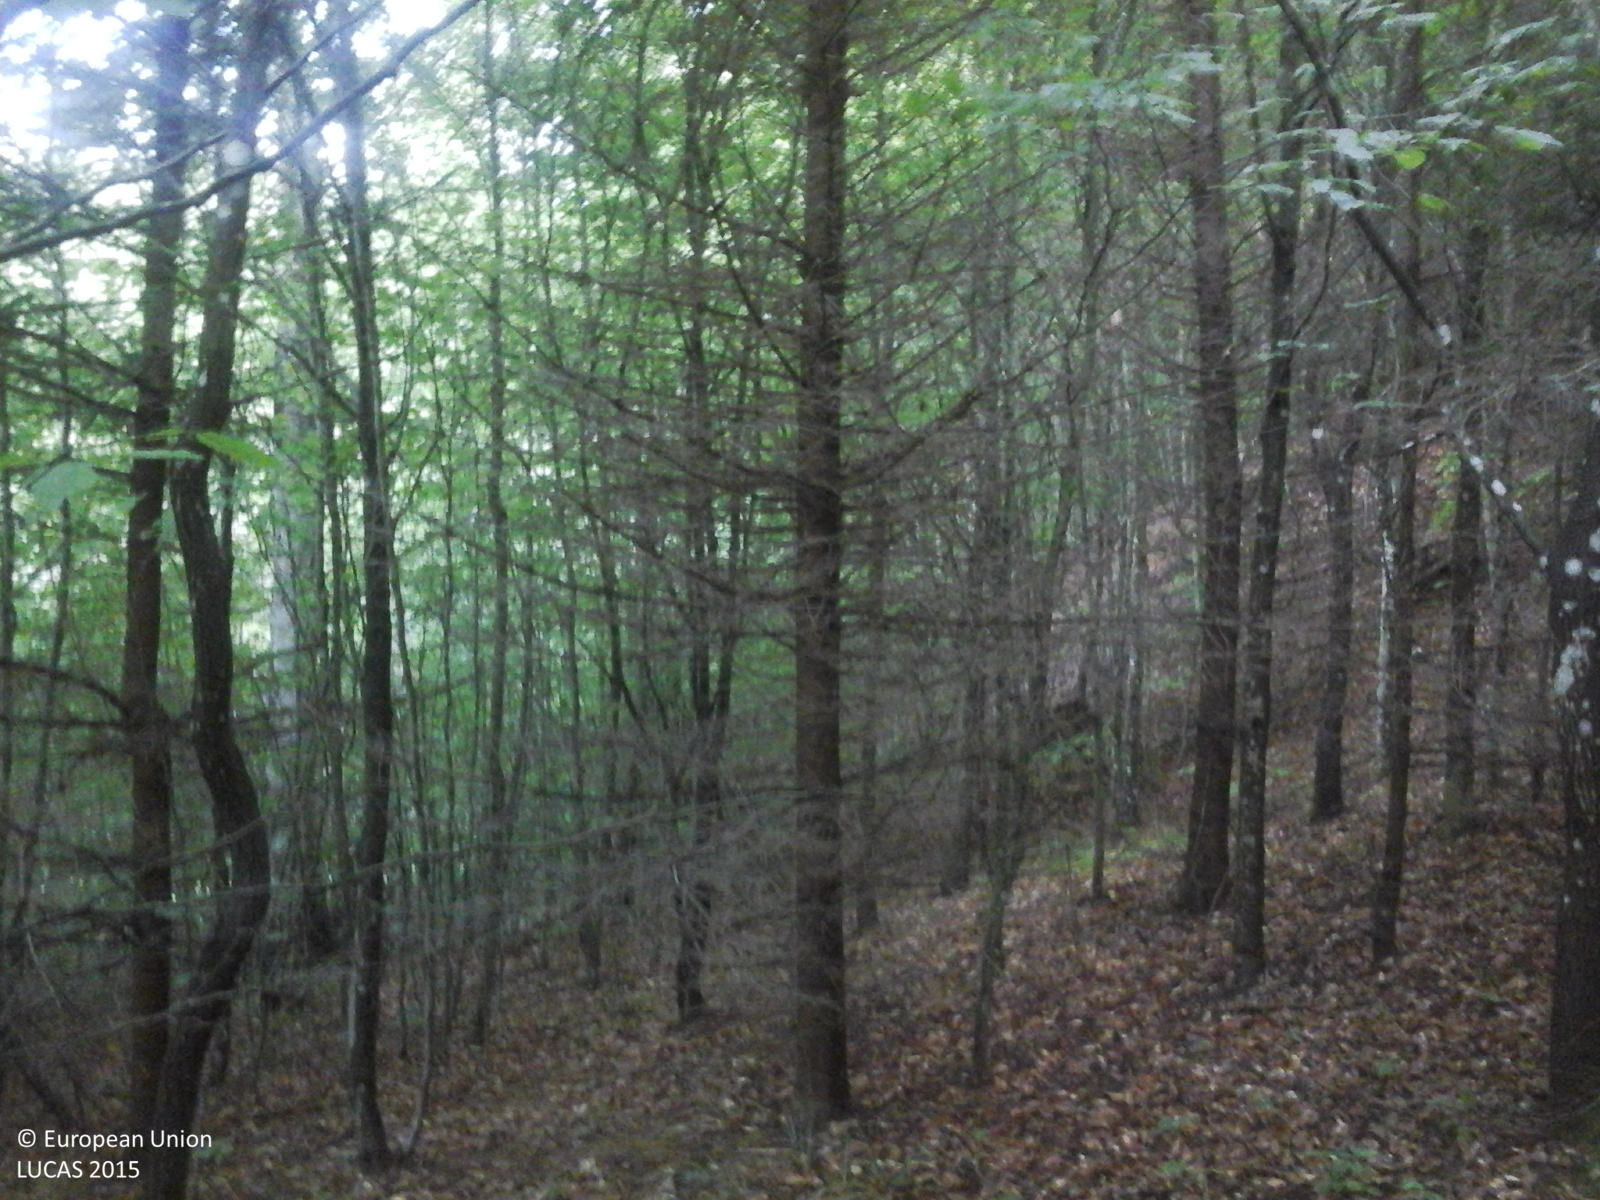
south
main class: Woodland
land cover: Broadleaved woodland
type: beech forest
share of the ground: > 75 %
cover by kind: broadleaved forest trees 85 %, coniferous forest trees 15 %
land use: Forestry
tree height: > 5 m
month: May
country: RO
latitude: 45.8422
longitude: 25.3320
